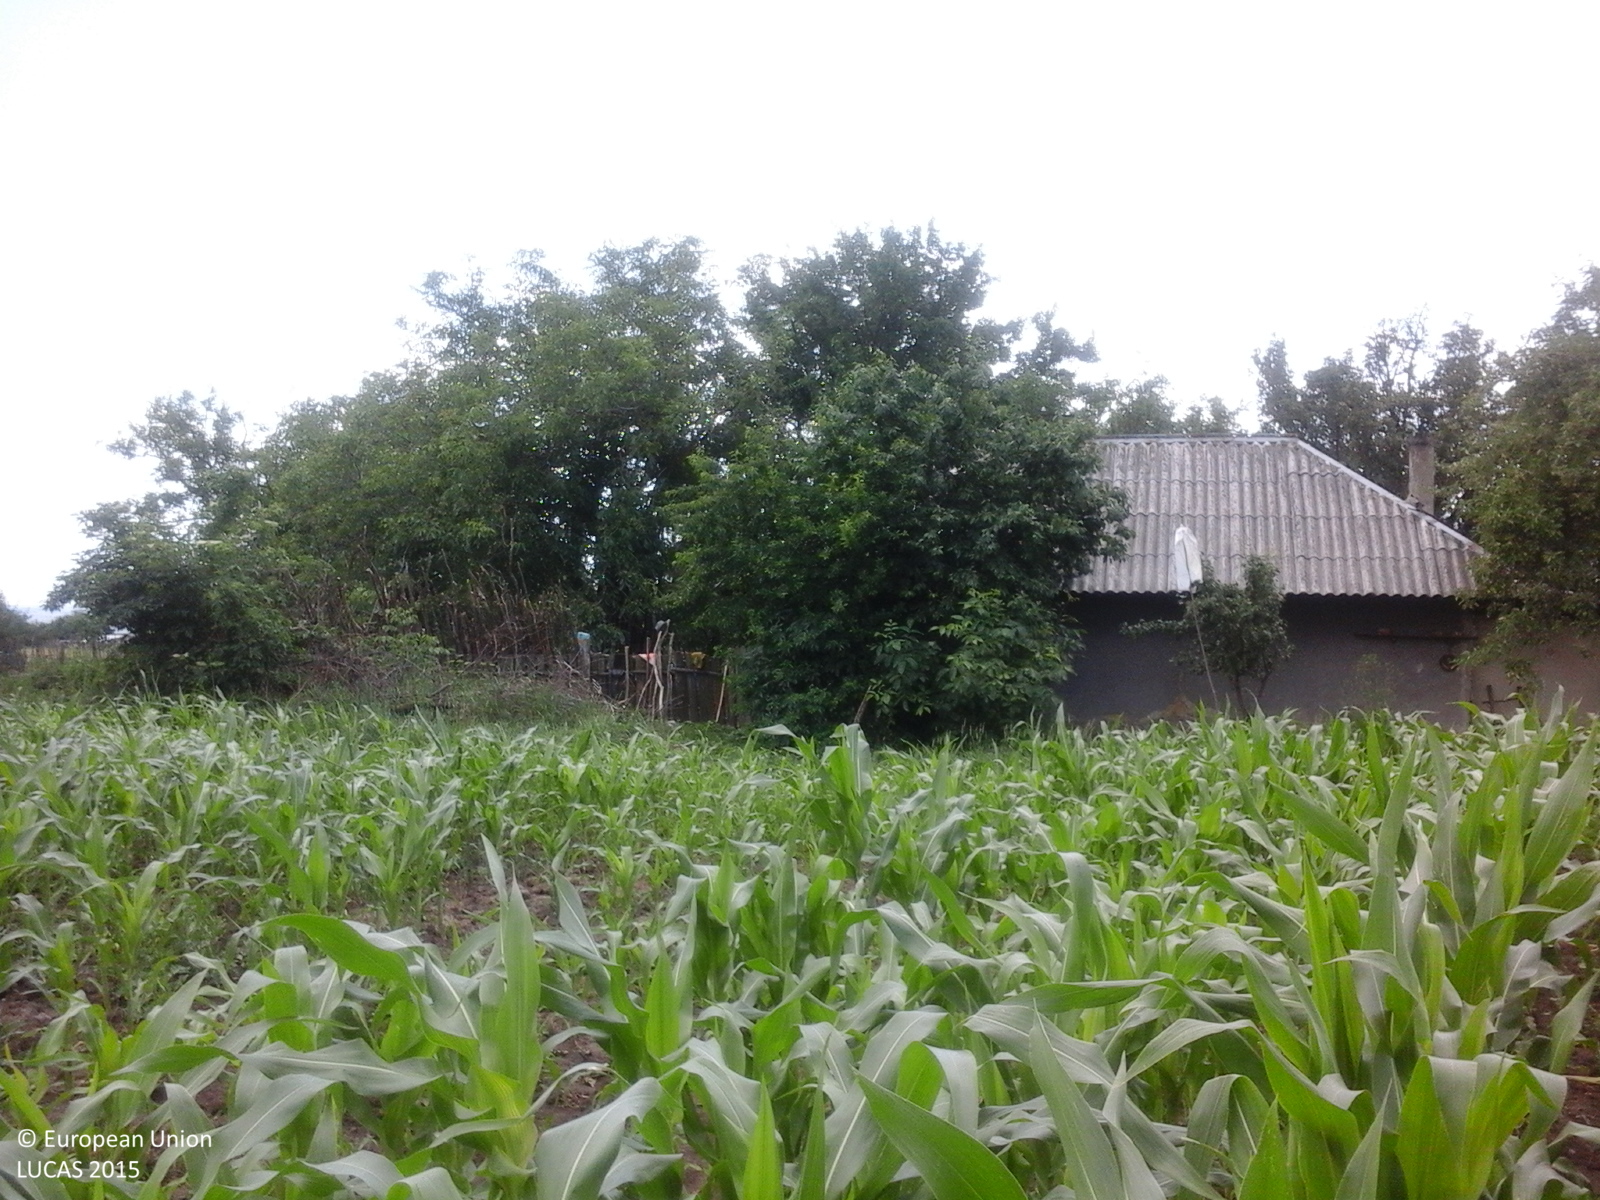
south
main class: Cropland
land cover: Maize
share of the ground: 50 - 75 %
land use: Agriculture (excluding fallow land and kitchen gardens)
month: June
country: RO
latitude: 47.8114
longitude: 26.3934
